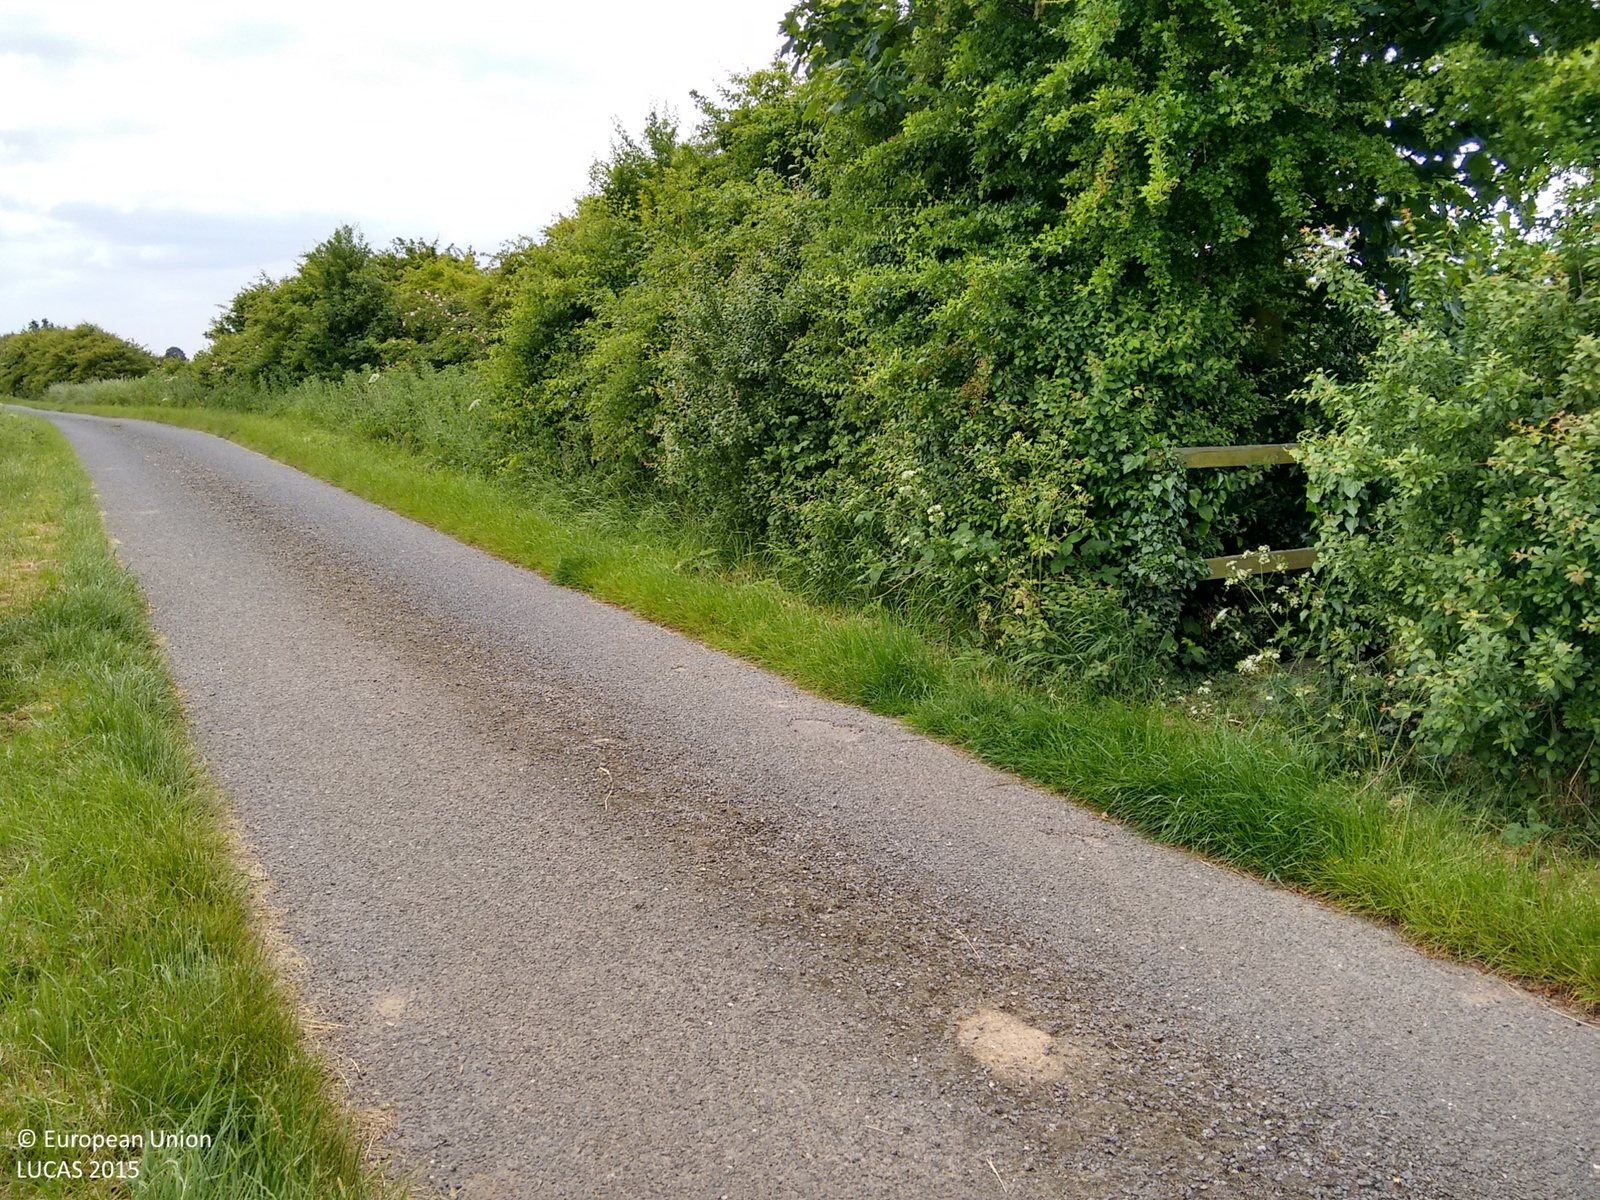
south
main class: Grassland
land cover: Grassland without tree/shrub cover
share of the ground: > 75 %
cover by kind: herbaceous plants 100 %
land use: Agriculture (excluding fallow land and kitchen gardens)
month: June
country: GB
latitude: 53.2451
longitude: 0.2751
